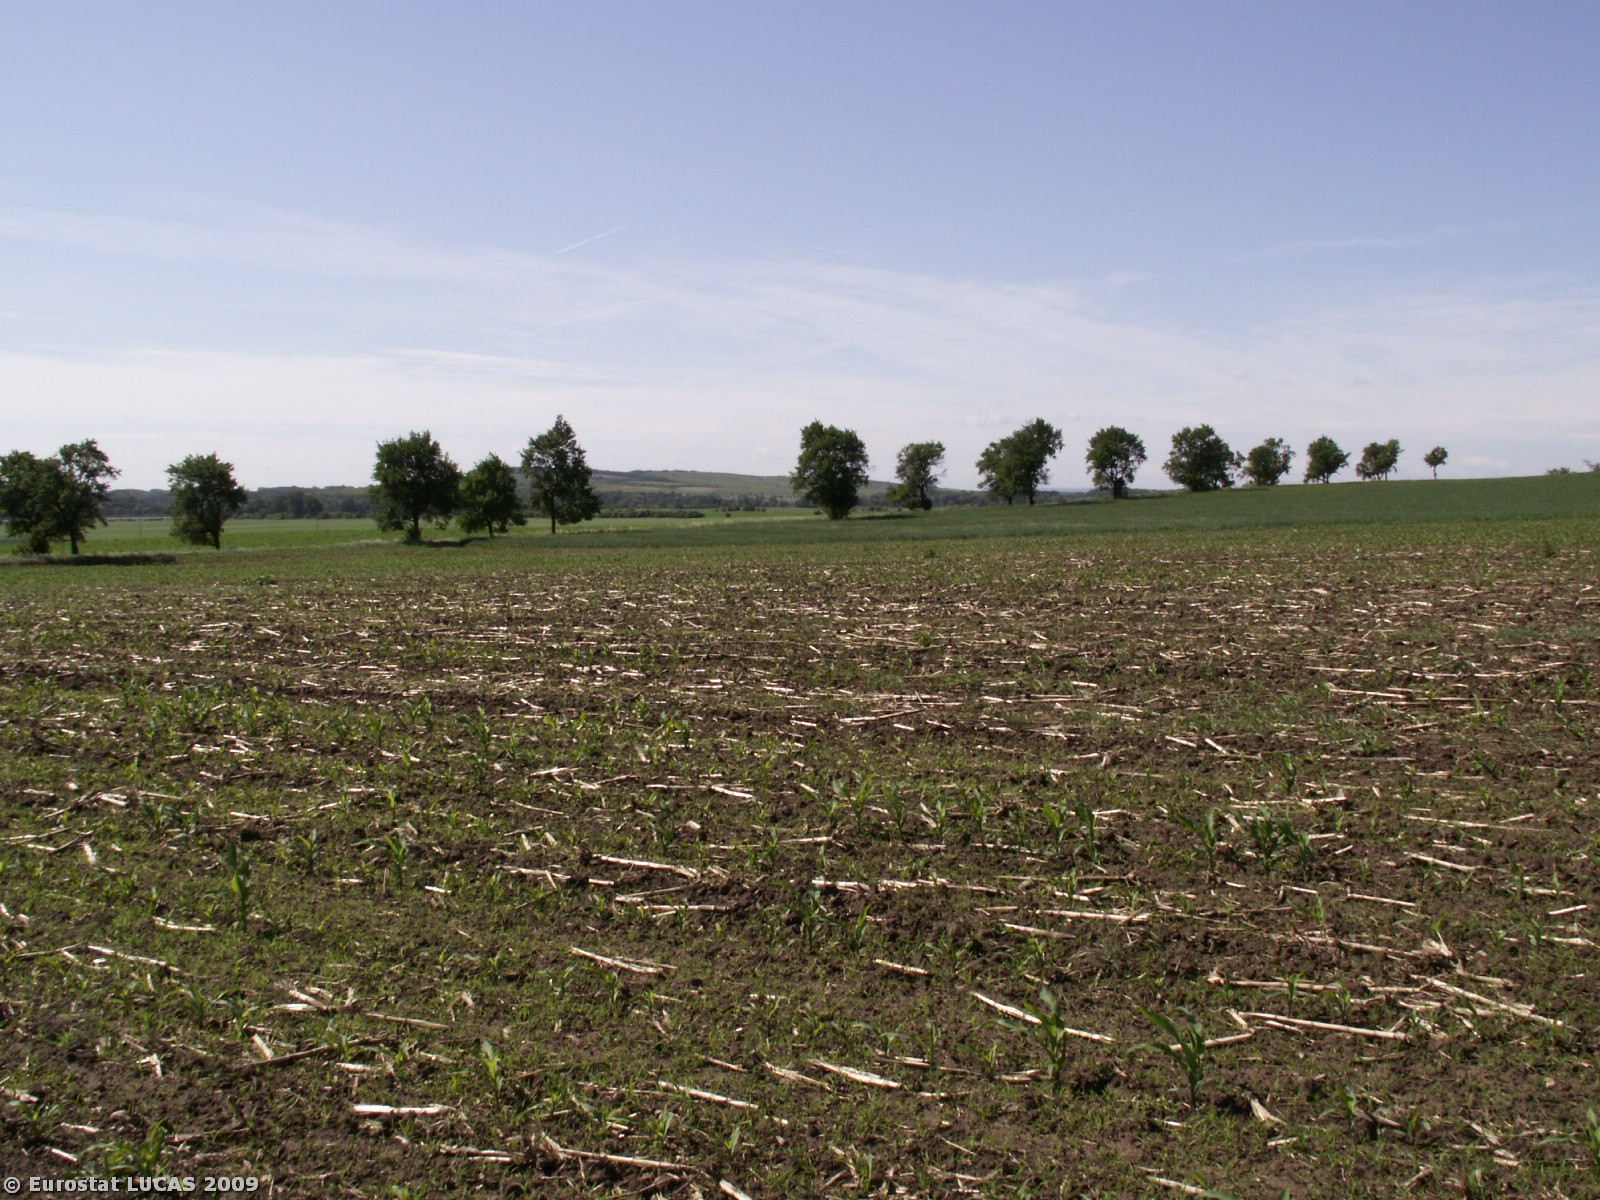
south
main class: Cropland
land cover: Other fresh vegetables
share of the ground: < 10 %
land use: Agriculture (excluding fallow land and kitchen gardens)
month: June
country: CZ
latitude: 48.8973
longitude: 16.5133
